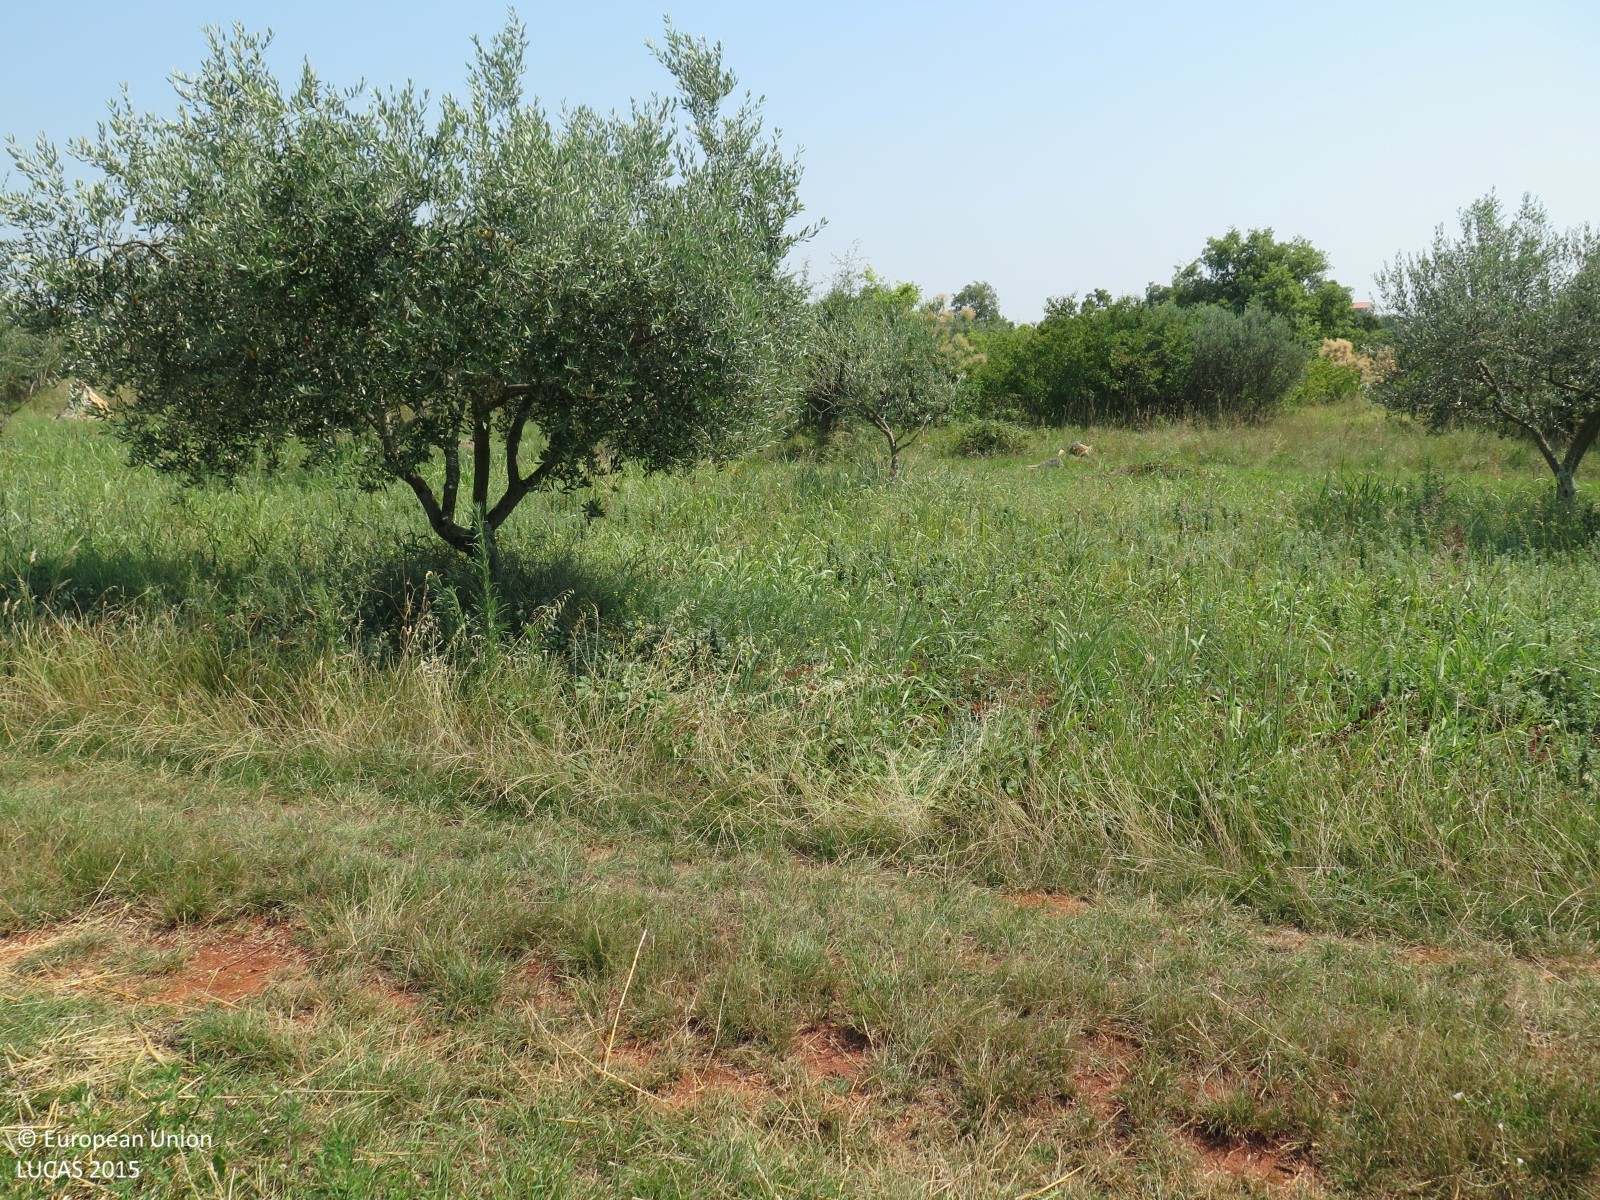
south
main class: Cropland
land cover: Oats
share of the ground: > 75 %
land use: Agriculture (excluding fallow land and kitchen gardens)
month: July
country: HR
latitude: 45.4623
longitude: 13.5635
